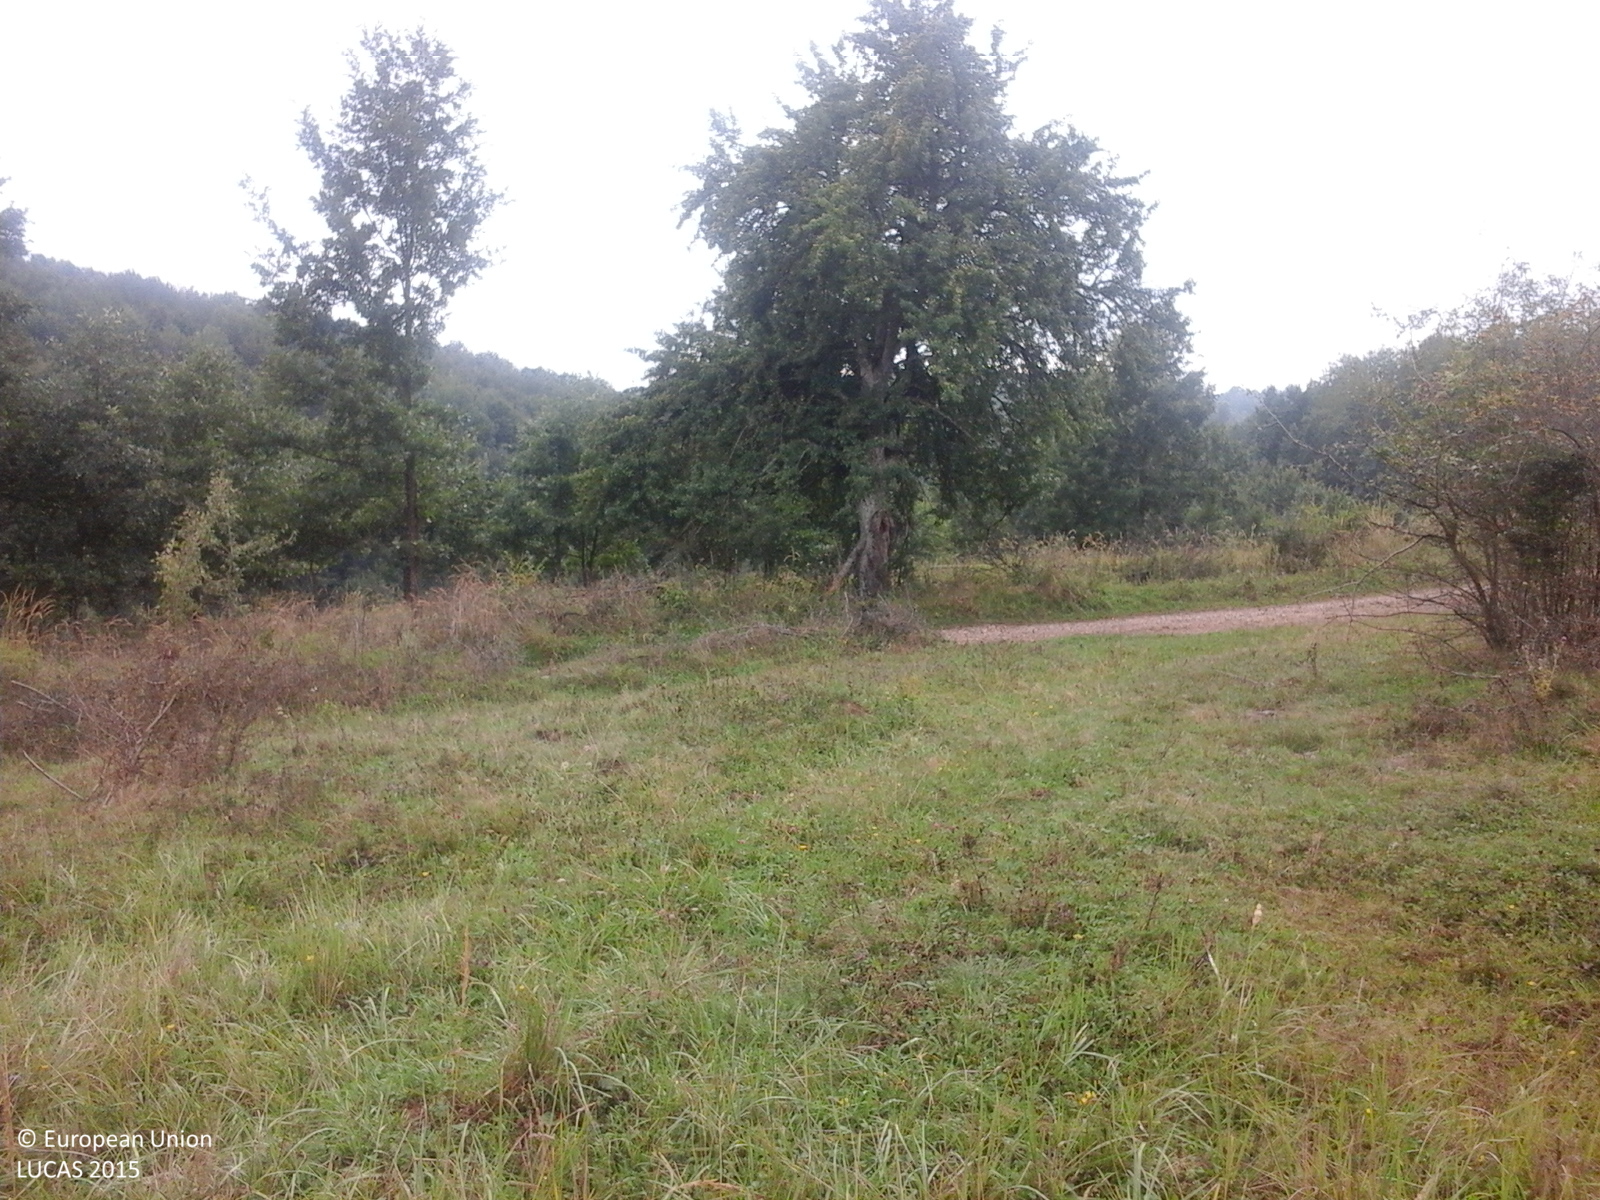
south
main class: Grassland
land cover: Grassland with sparse tree/shrub cover
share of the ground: > 75 %
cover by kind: herbaceous plants 85 %, shrubs 10 %, broadleaved forest trees 5 %
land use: Fallow land
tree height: < 5 m
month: September
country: RO
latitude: 46.9448
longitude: 22.4953
